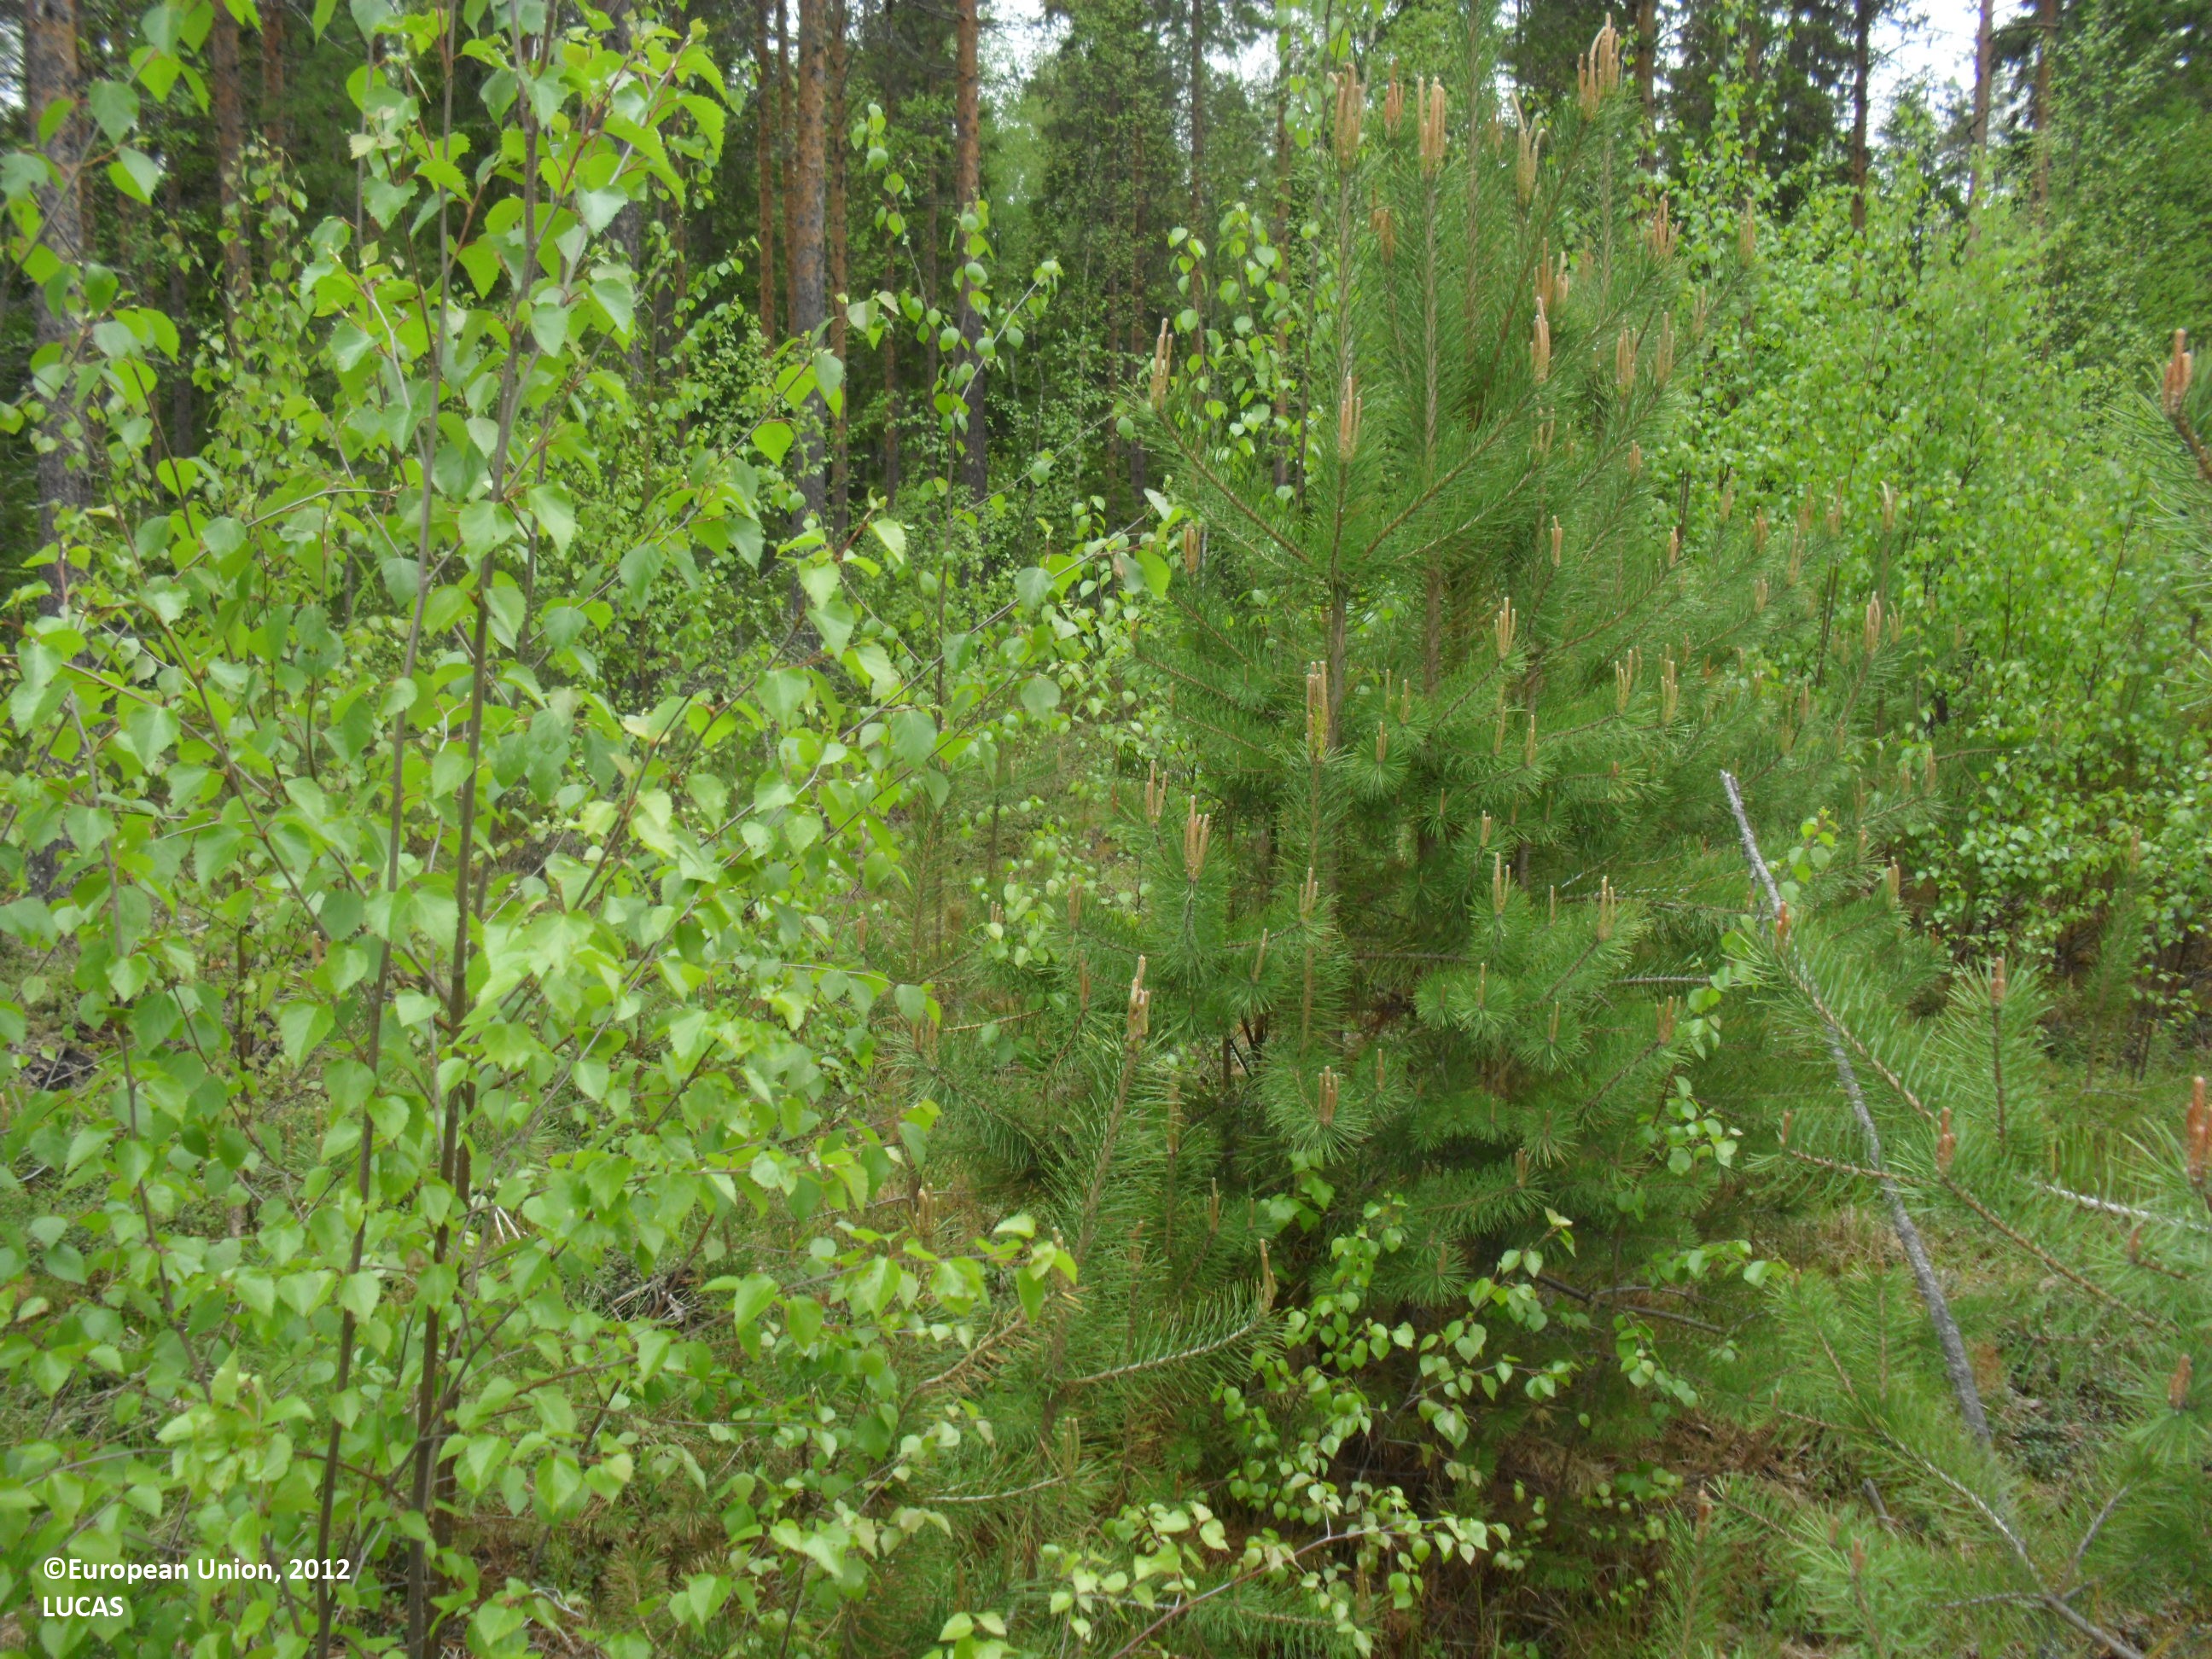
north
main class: Woodland
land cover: Pine dominated mixed woodland
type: boreal forest
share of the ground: < 10 %
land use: Forestry
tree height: < 5 m
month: June
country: FI
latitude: 62.7953
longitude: 23.0207
